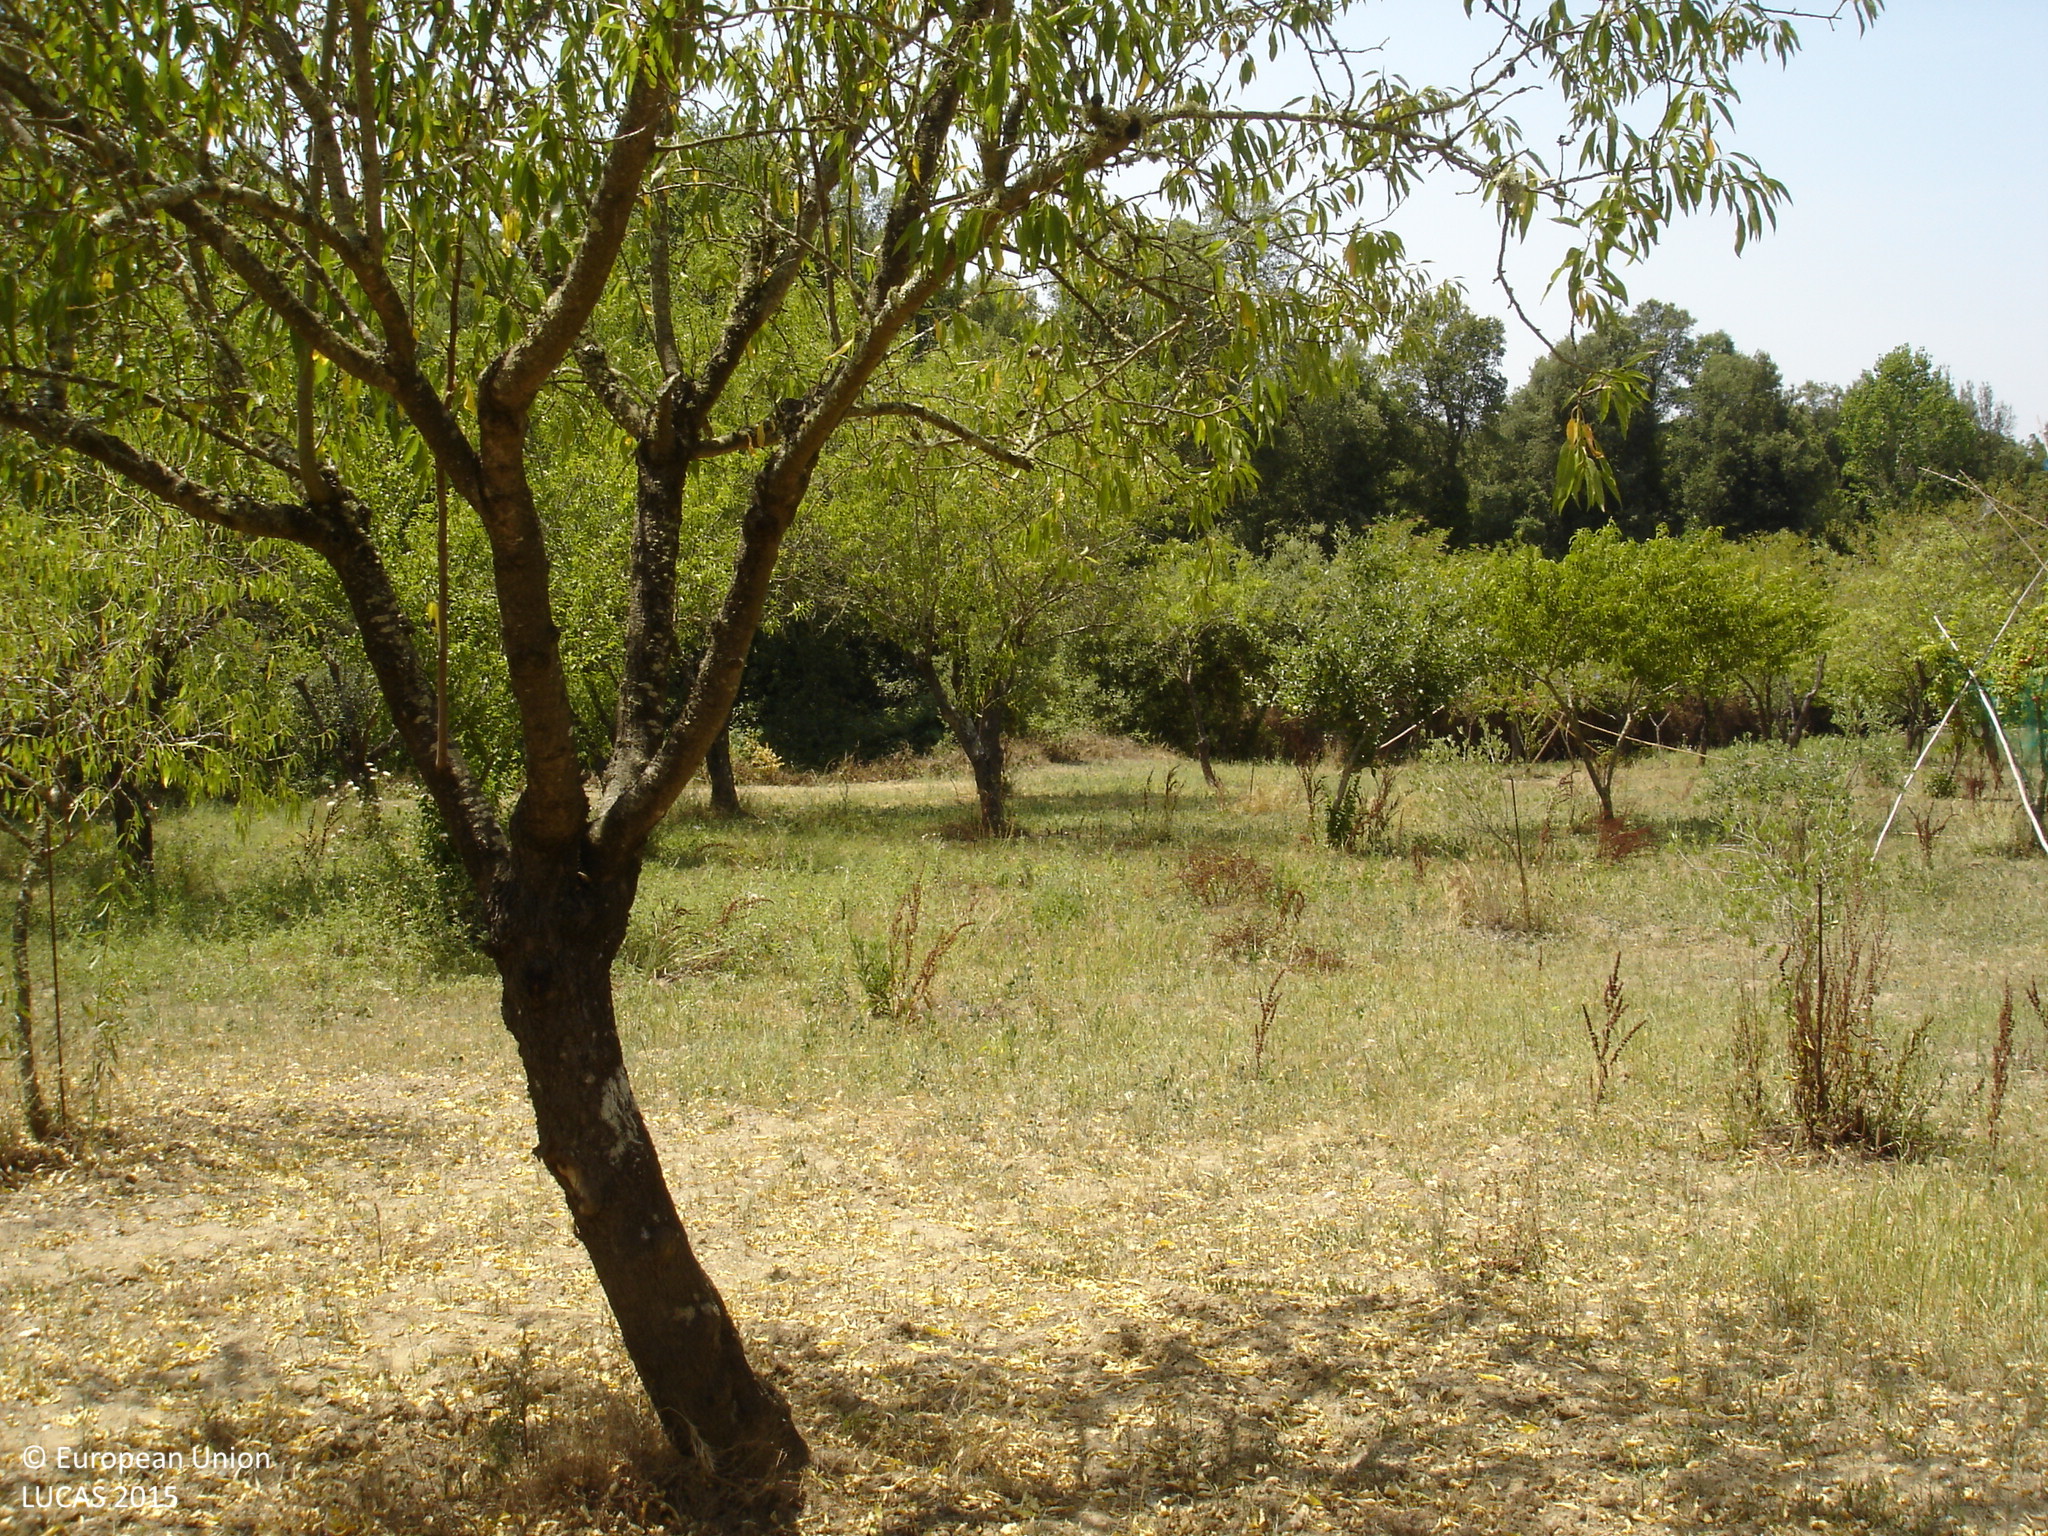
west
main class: Shrubland
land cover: Shrubland with sparse tree cover
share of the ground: > 75 %
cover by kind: shrubs 90 %, coniferous forest trees 5 %, herbaceous plants 5 %
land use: Semi-natural and natural areas not in use
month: July
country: ES
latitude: 41.9247
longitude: 3.0342
